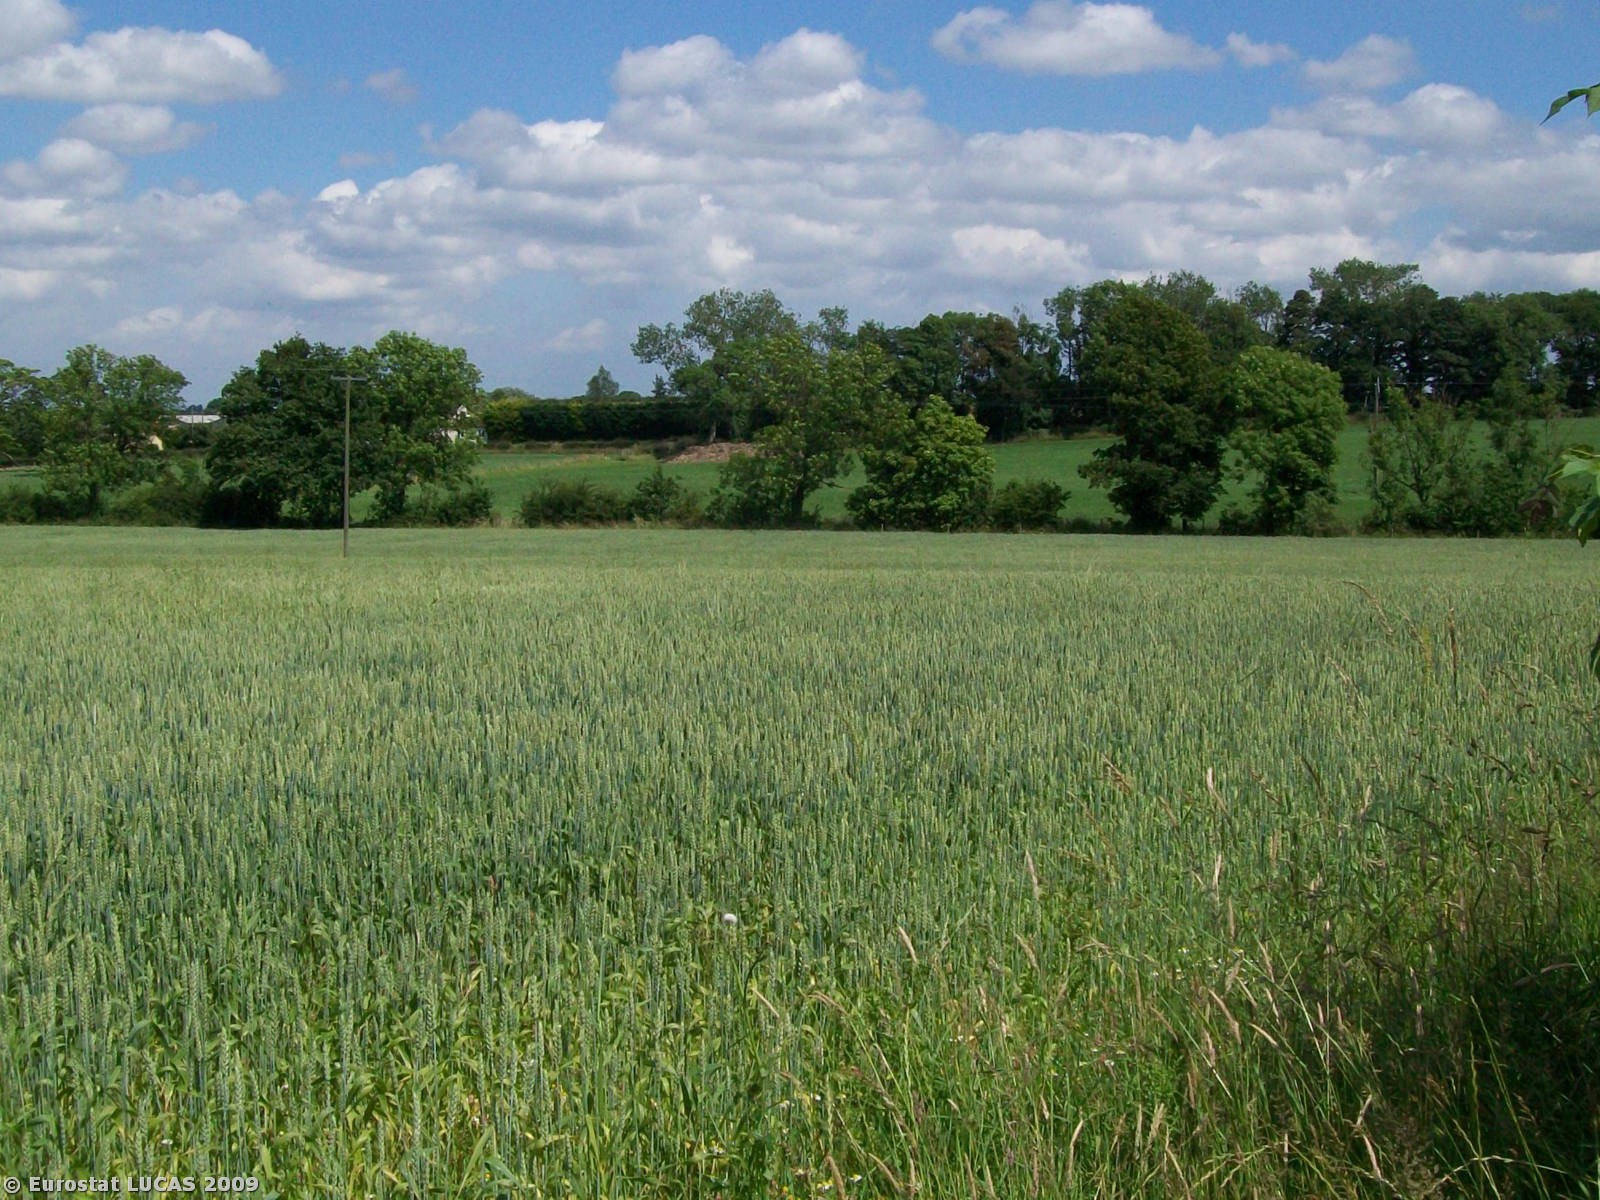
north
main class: Cropland
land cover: Common wheat
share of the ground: < 10 %
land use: Agriculture (excluding fallow land and kitchen gardens)
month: July
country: GB
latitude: 54.3588
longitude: -1.5132
